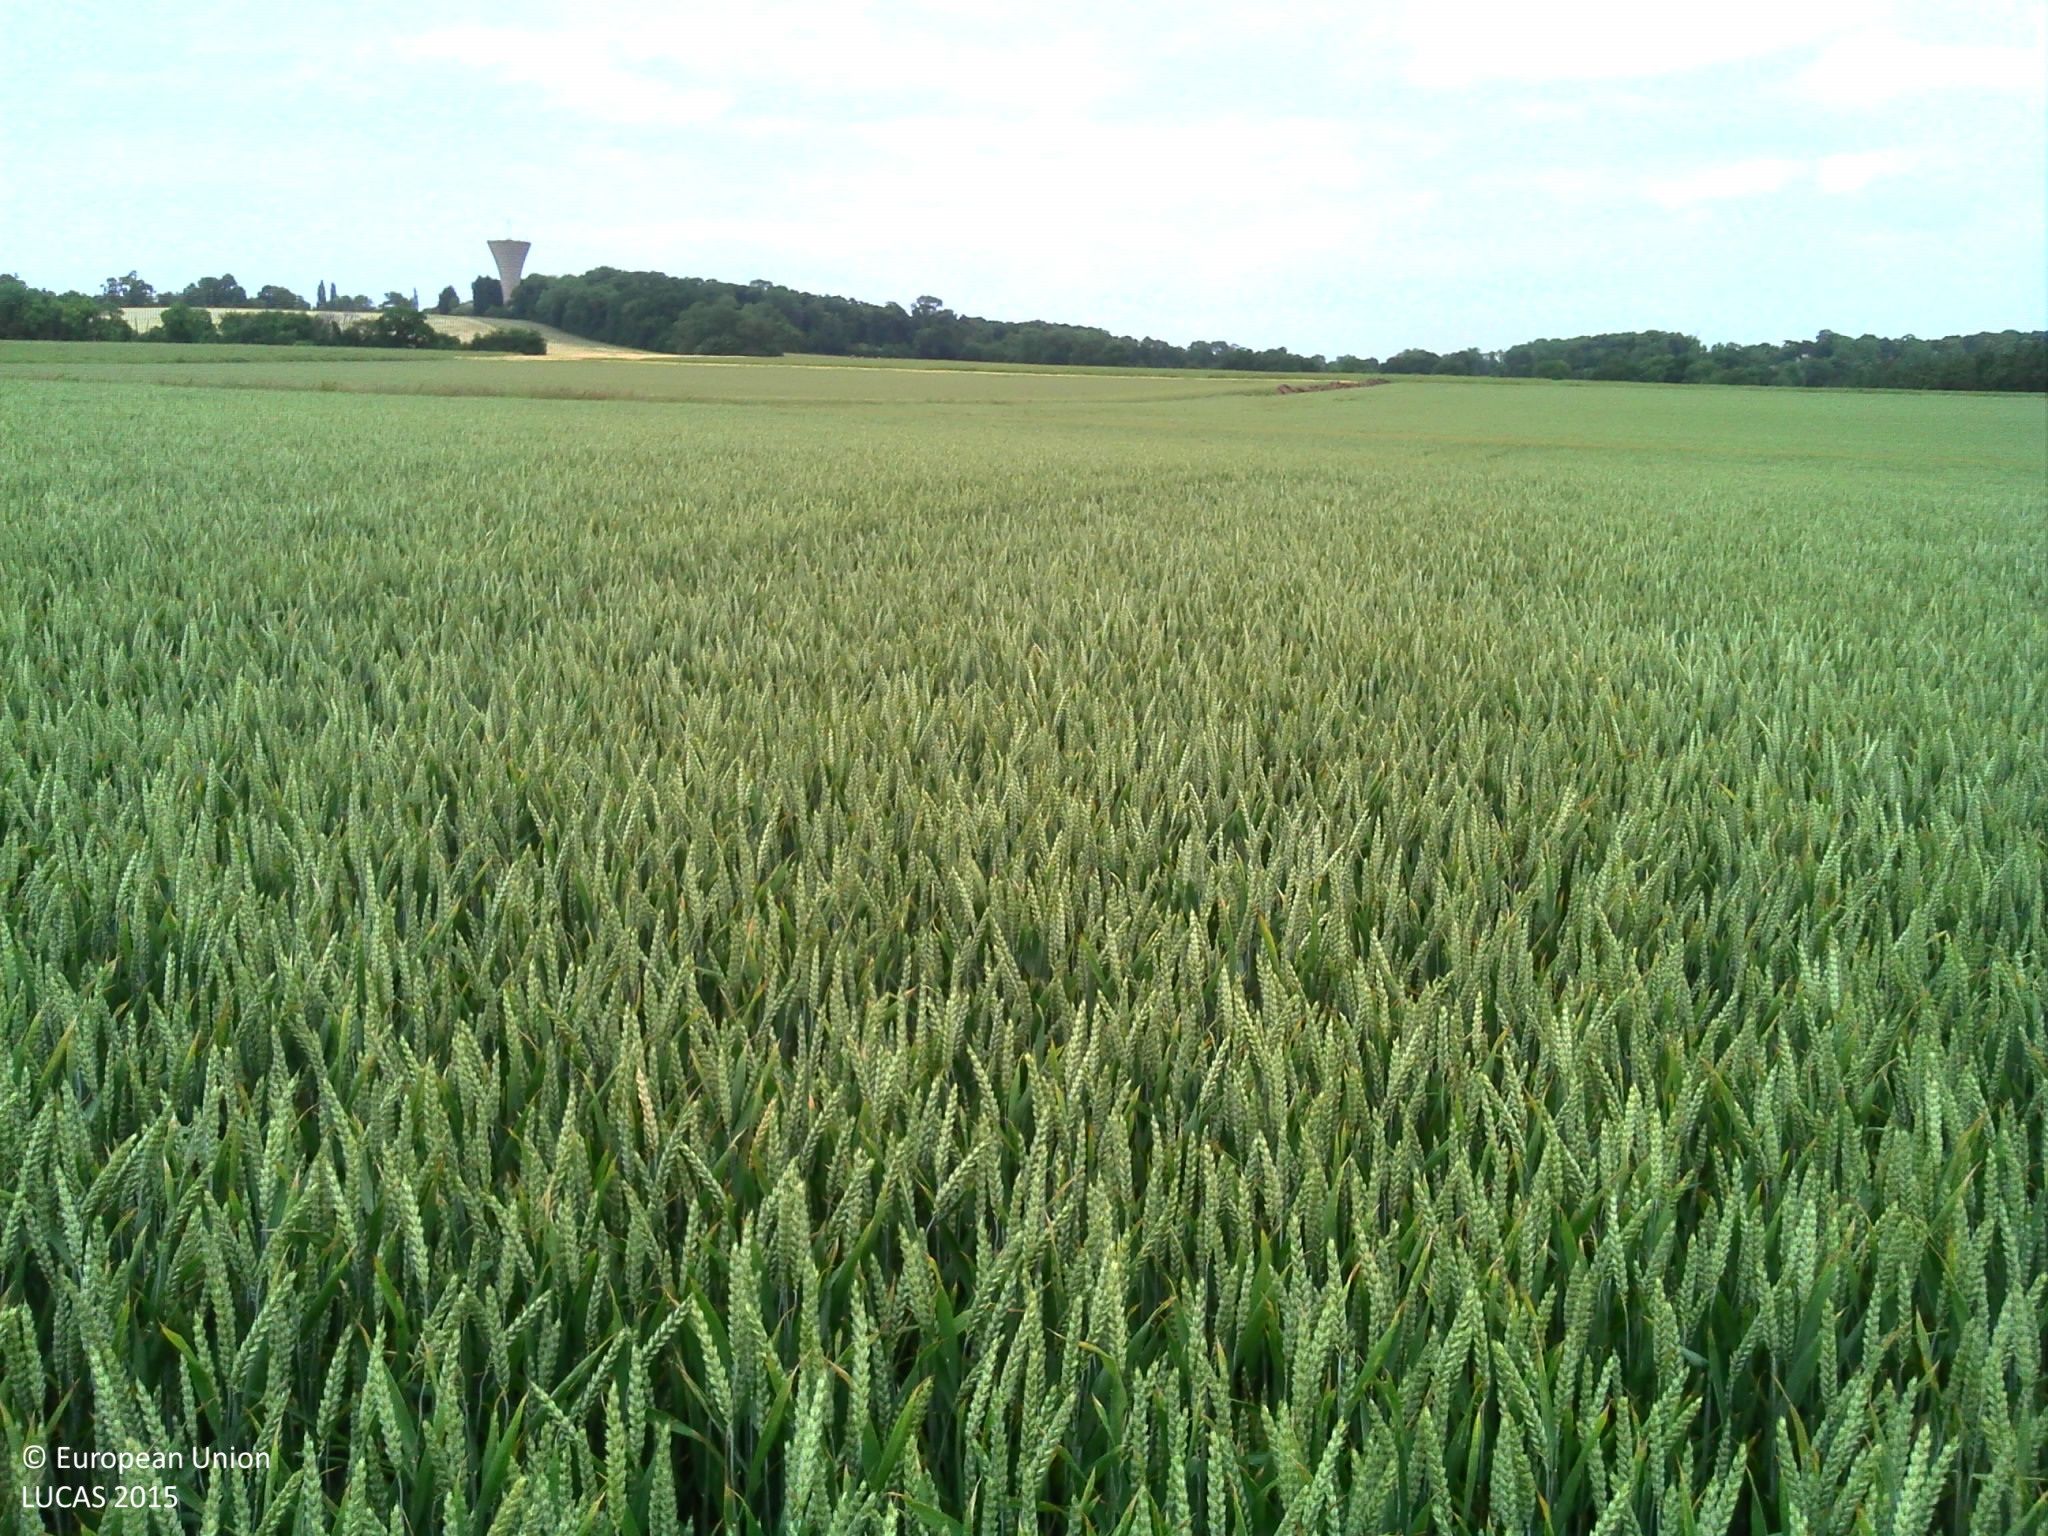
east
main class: Cropland
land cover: Common wheat
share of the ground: > 75 %
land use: Agriculture (excluding fallow land and kitchen gardens)
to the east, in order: Common wheat; Grass margins; Tracks; Grass margins; Common wheat
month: June
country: FR
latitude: 49.2327
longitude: -0.2373
